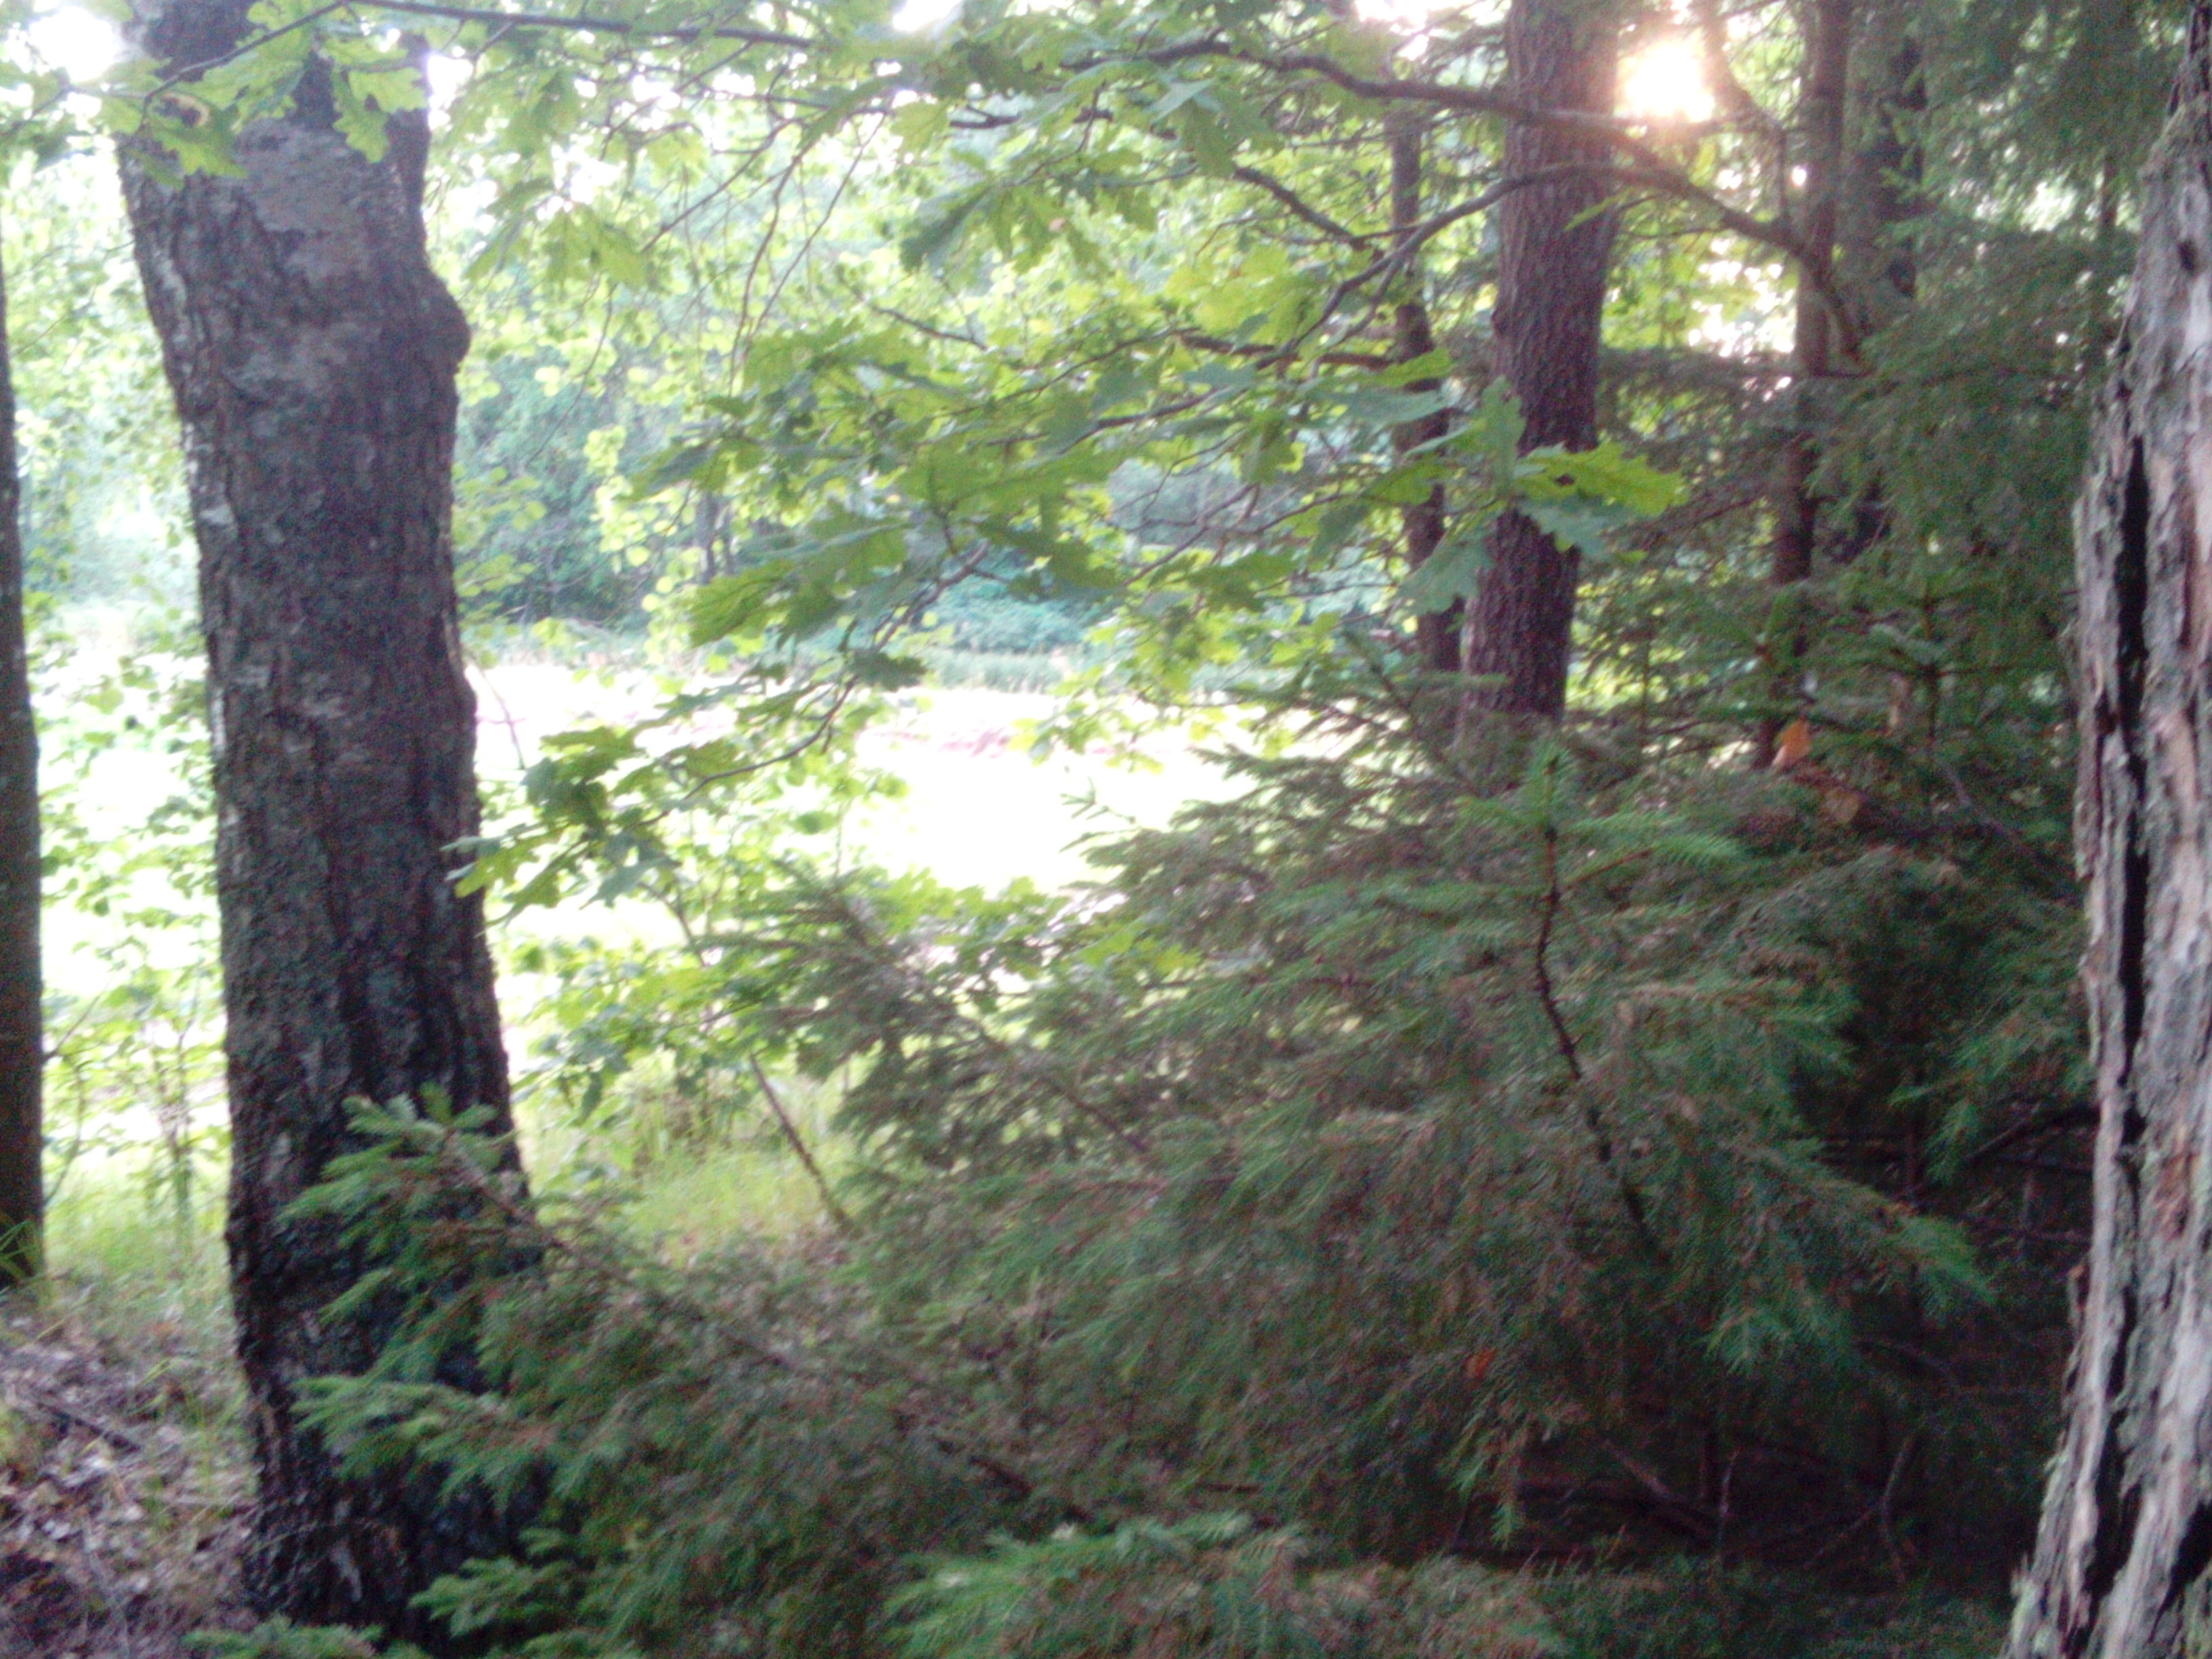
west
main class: Woodland
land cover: Spruce dominated mixed woodland
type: hemiboreal forest and nemoral coniferous forest and mixed broadleaved-coniferous forest
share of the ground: > 75 %
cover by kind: broadleaved forest trees 60 %, coniferous forest trees 25 %, herbaceous plants 15 %
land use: Forestry
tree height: > 5 m
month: July
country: LV
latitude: 56.6327
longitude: 21.8992
